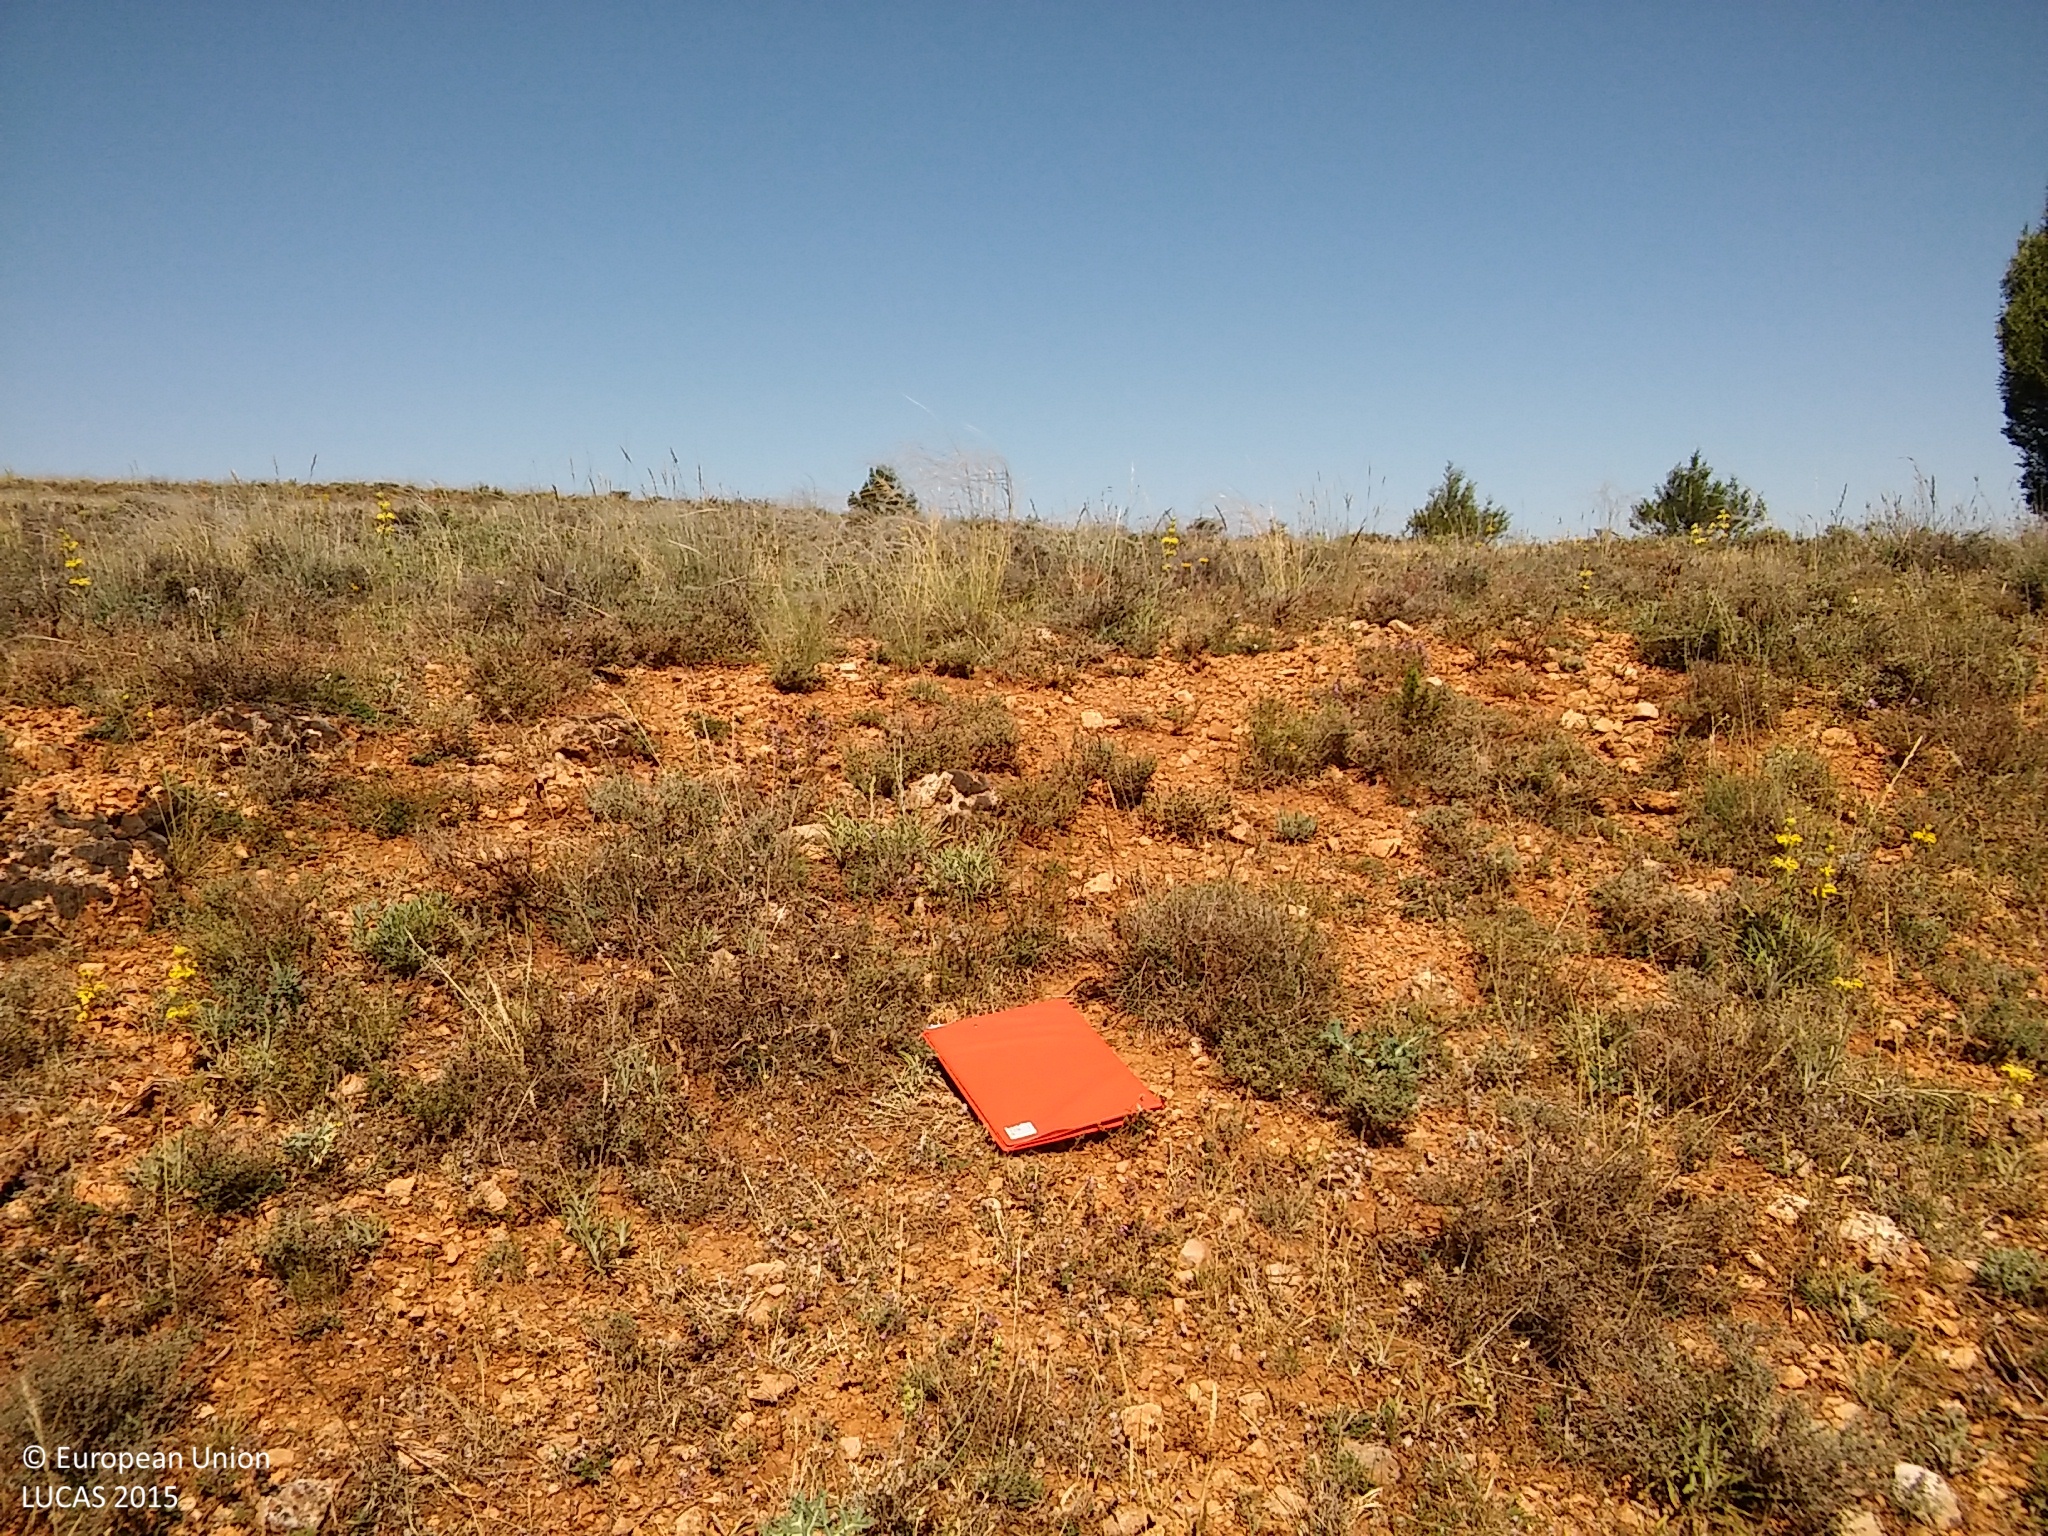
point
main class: Shrubland
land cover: Shrubland without tree cover
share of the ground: 50 - 75 %
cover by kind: shrubs 50 %, unconsolidated bare surface 50 %
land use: Agriculture (excluding fallow land and kitchen gardens)
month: June
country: ES
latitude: 41.4422
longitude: -3.1729
